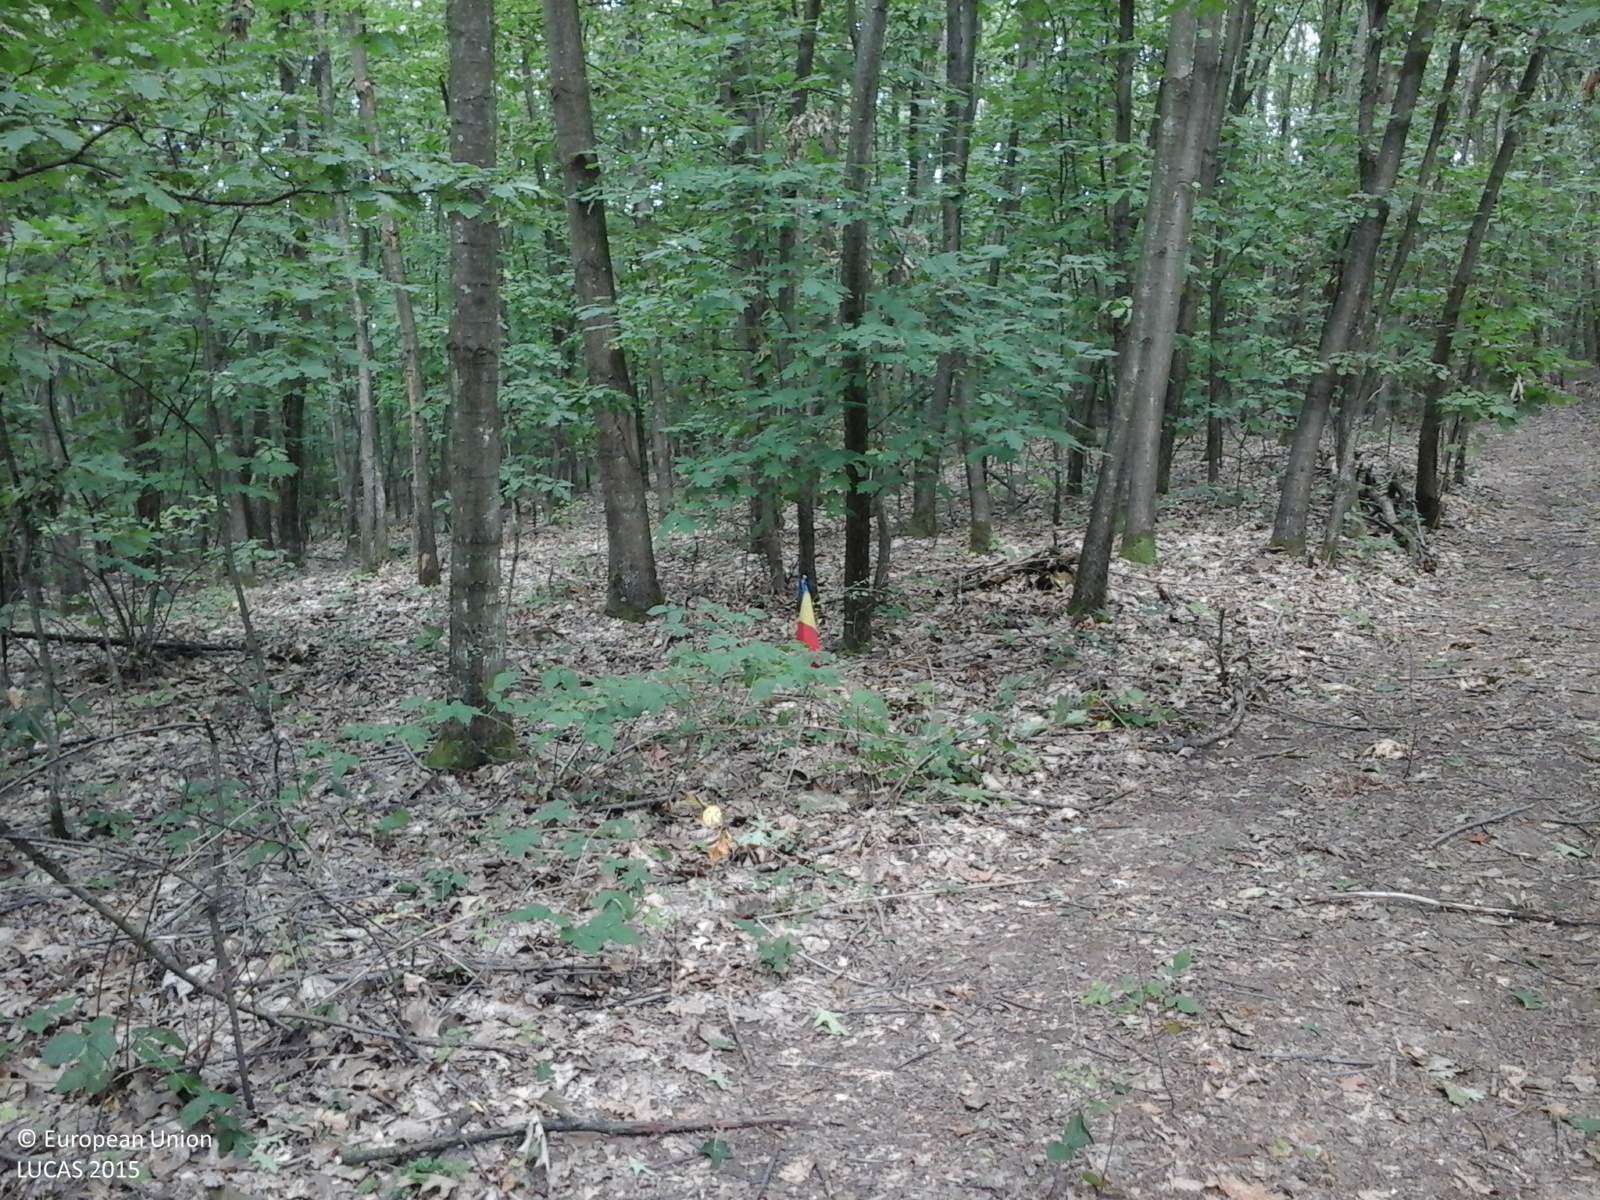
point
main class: Woodland
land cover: Broadleaved woodland
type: mesophytic deciduous forest
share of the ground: > 75 %
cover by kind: broadleaved forest trees 100 %
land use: Forestry
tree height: > 5 m
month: September
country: RO
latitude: 47.5598
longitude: 23.2943
